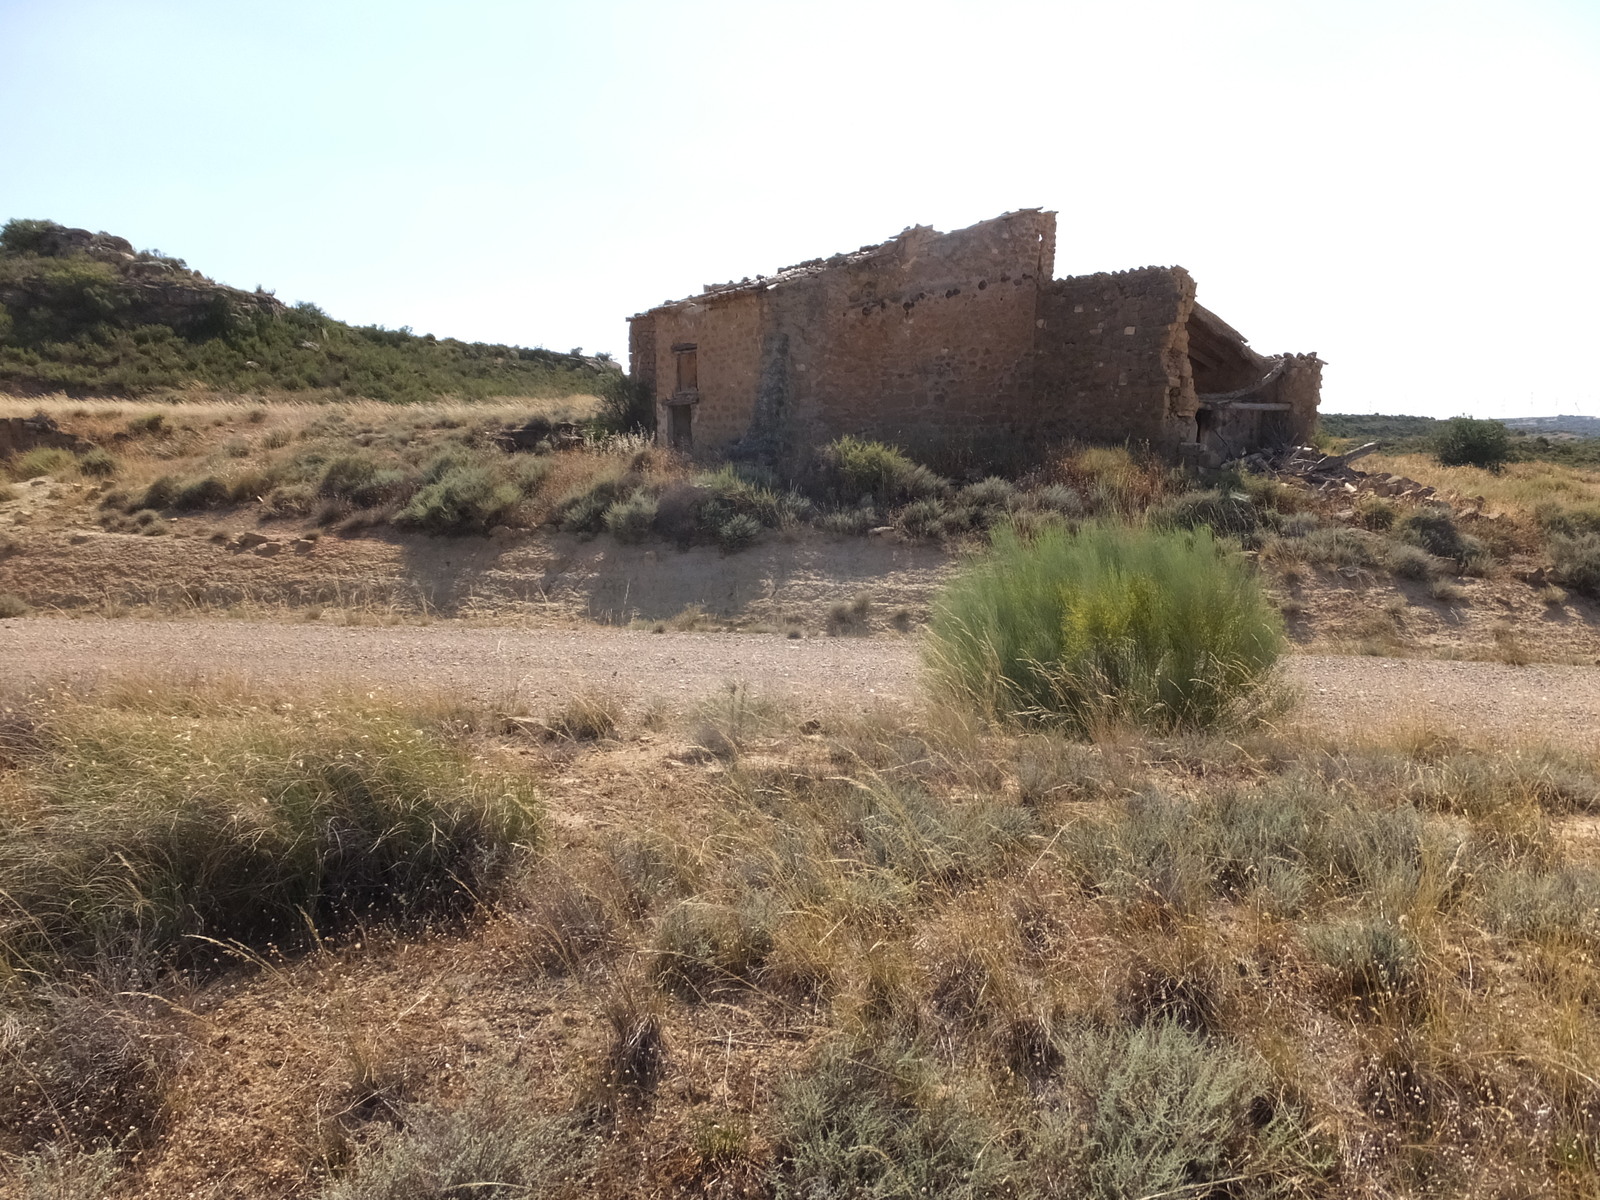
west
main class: Grassland
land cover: Grassland without tree/shrub cover
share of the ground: > 75 %
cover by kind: herbaceous plants 50 %, consolidated bare surface 50 %
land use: Semi-natural and natural areas not in use
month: June
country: ES
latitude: 41.2445
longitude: -0.2161
